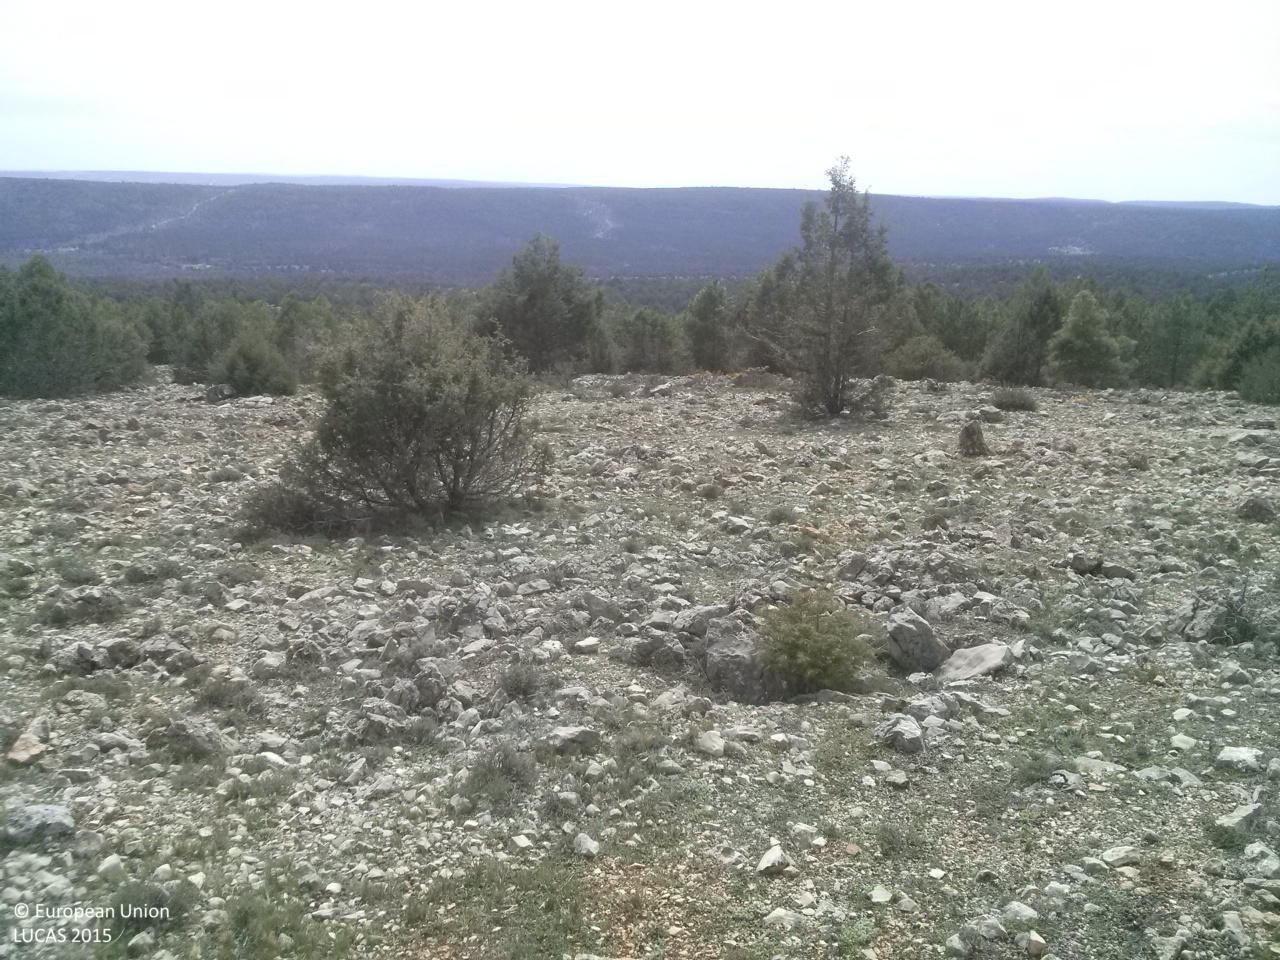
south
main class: Grassland
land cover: Grassland with sparse tree/shrub cover
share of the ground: 50 - 75 %
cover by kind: consolidated bare surface 55 %, herbaceous plants 35 %, coniferous forest trees 5 %, shrubs 5 %
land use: Semi-natural and natural areas not in use
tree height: < 5 m
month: April
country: ES
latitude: 40.0561
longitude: -1.8651
